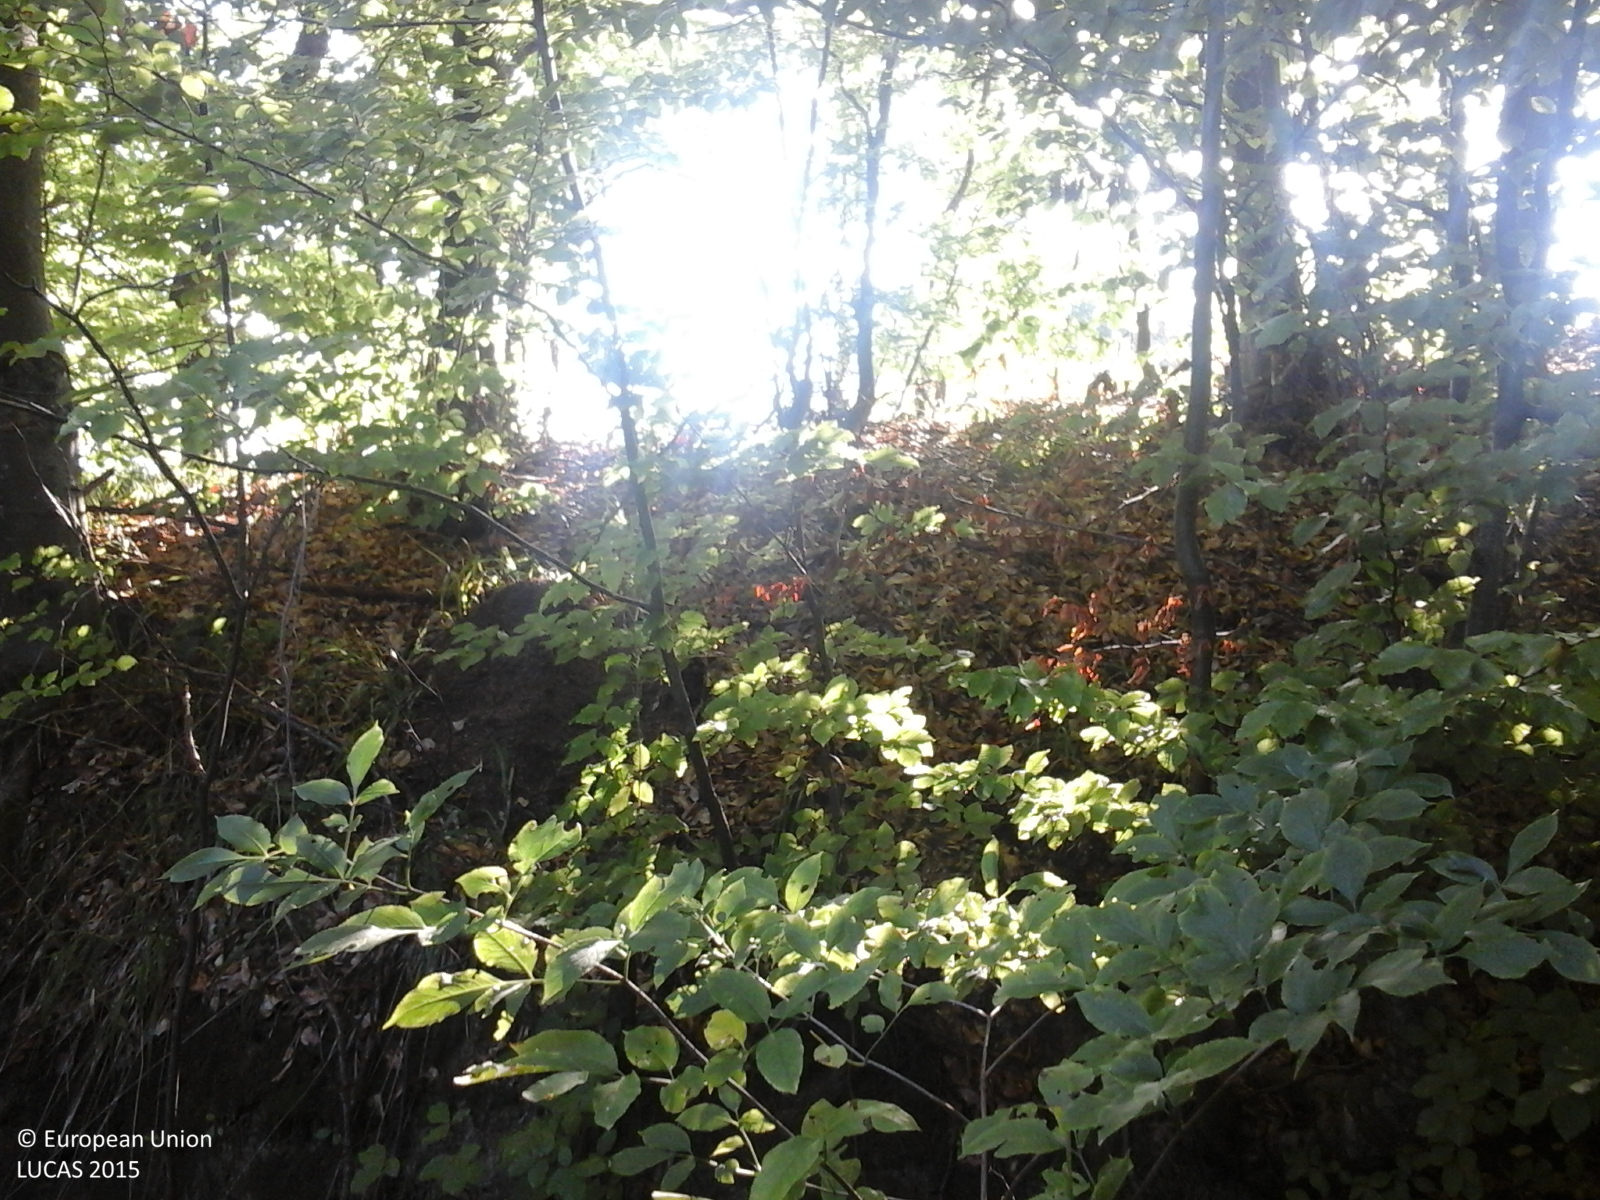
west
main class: Woodland
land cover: Broadleaved woodland
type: mesophytic deciduous forest
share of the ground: > 75 %
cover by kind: broadleaved forest trees 100 %
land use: Forestry
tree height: > 5 m
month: September
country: RO
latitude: 47.2900
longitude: 23.8438
